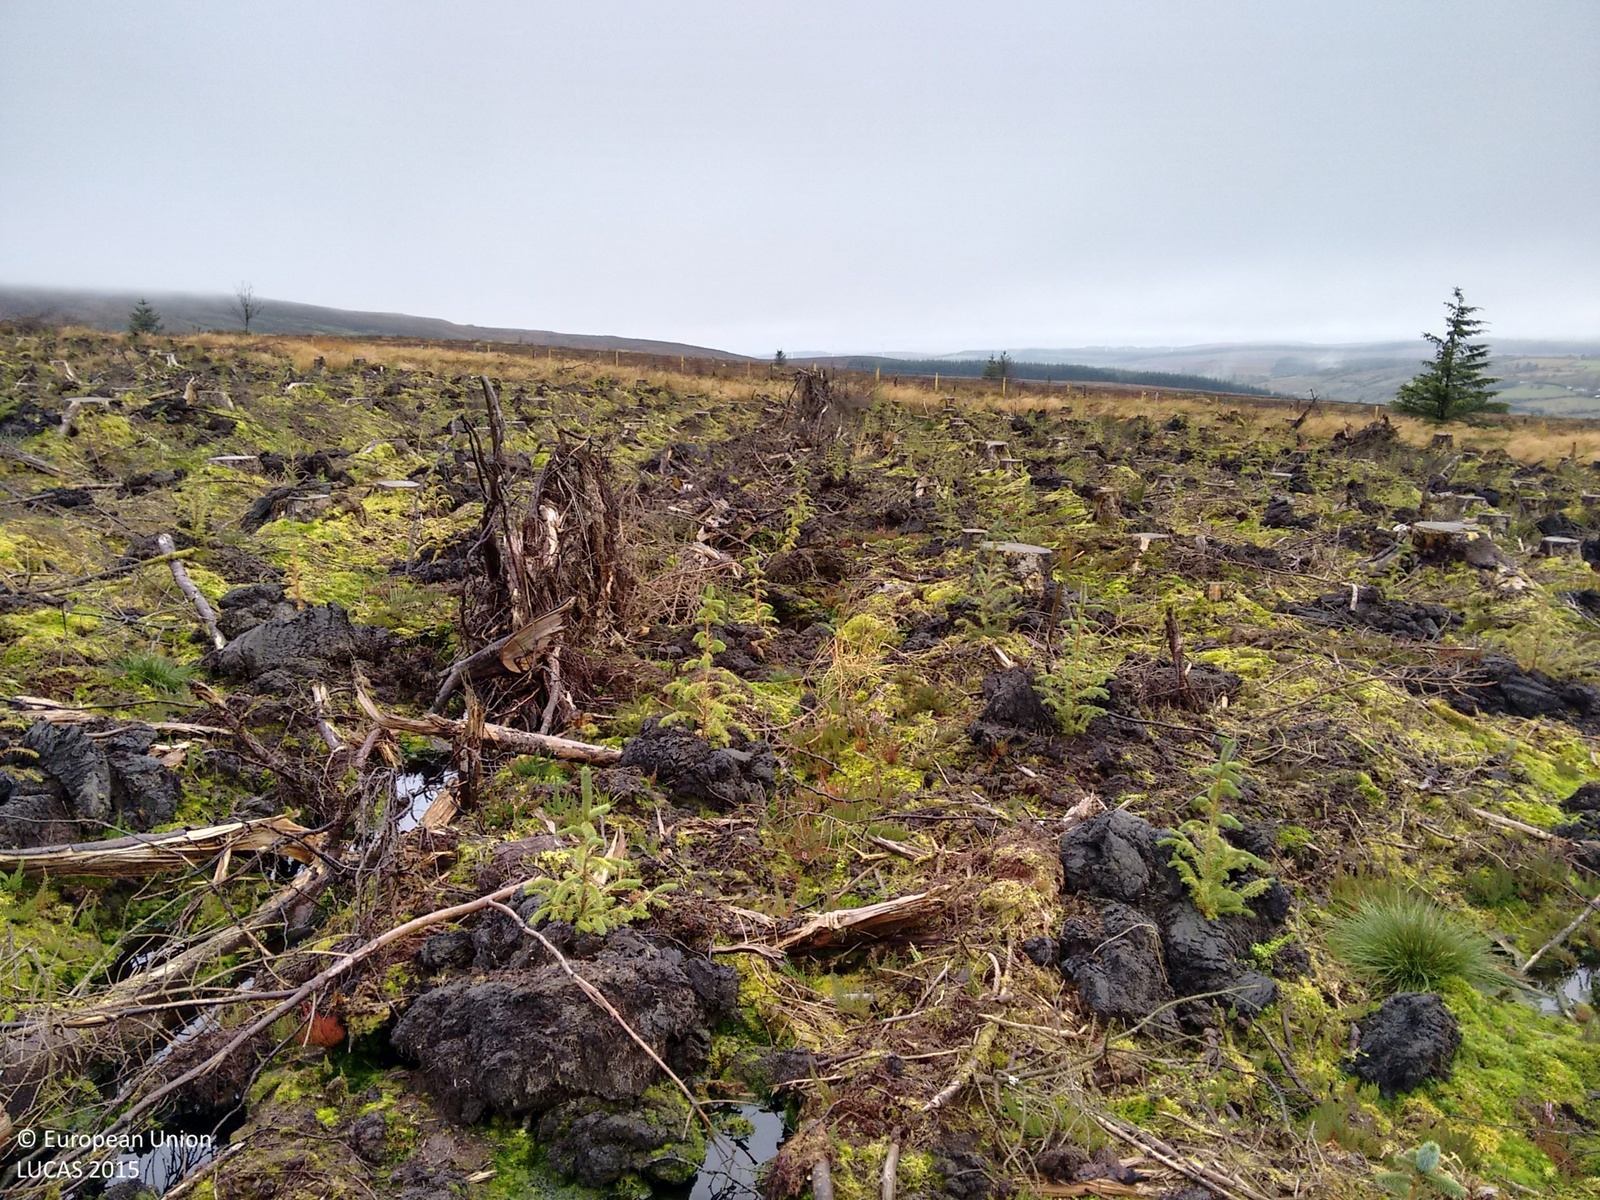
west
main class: Shrubland
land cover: Shrubland without tree cover
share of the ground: > 75 %
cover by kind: shrubs 80 %, lichens and mosses 20 %
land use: Forestry
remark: Clear cut
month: October
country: GB
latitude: 54.5785
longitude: -7.5306
